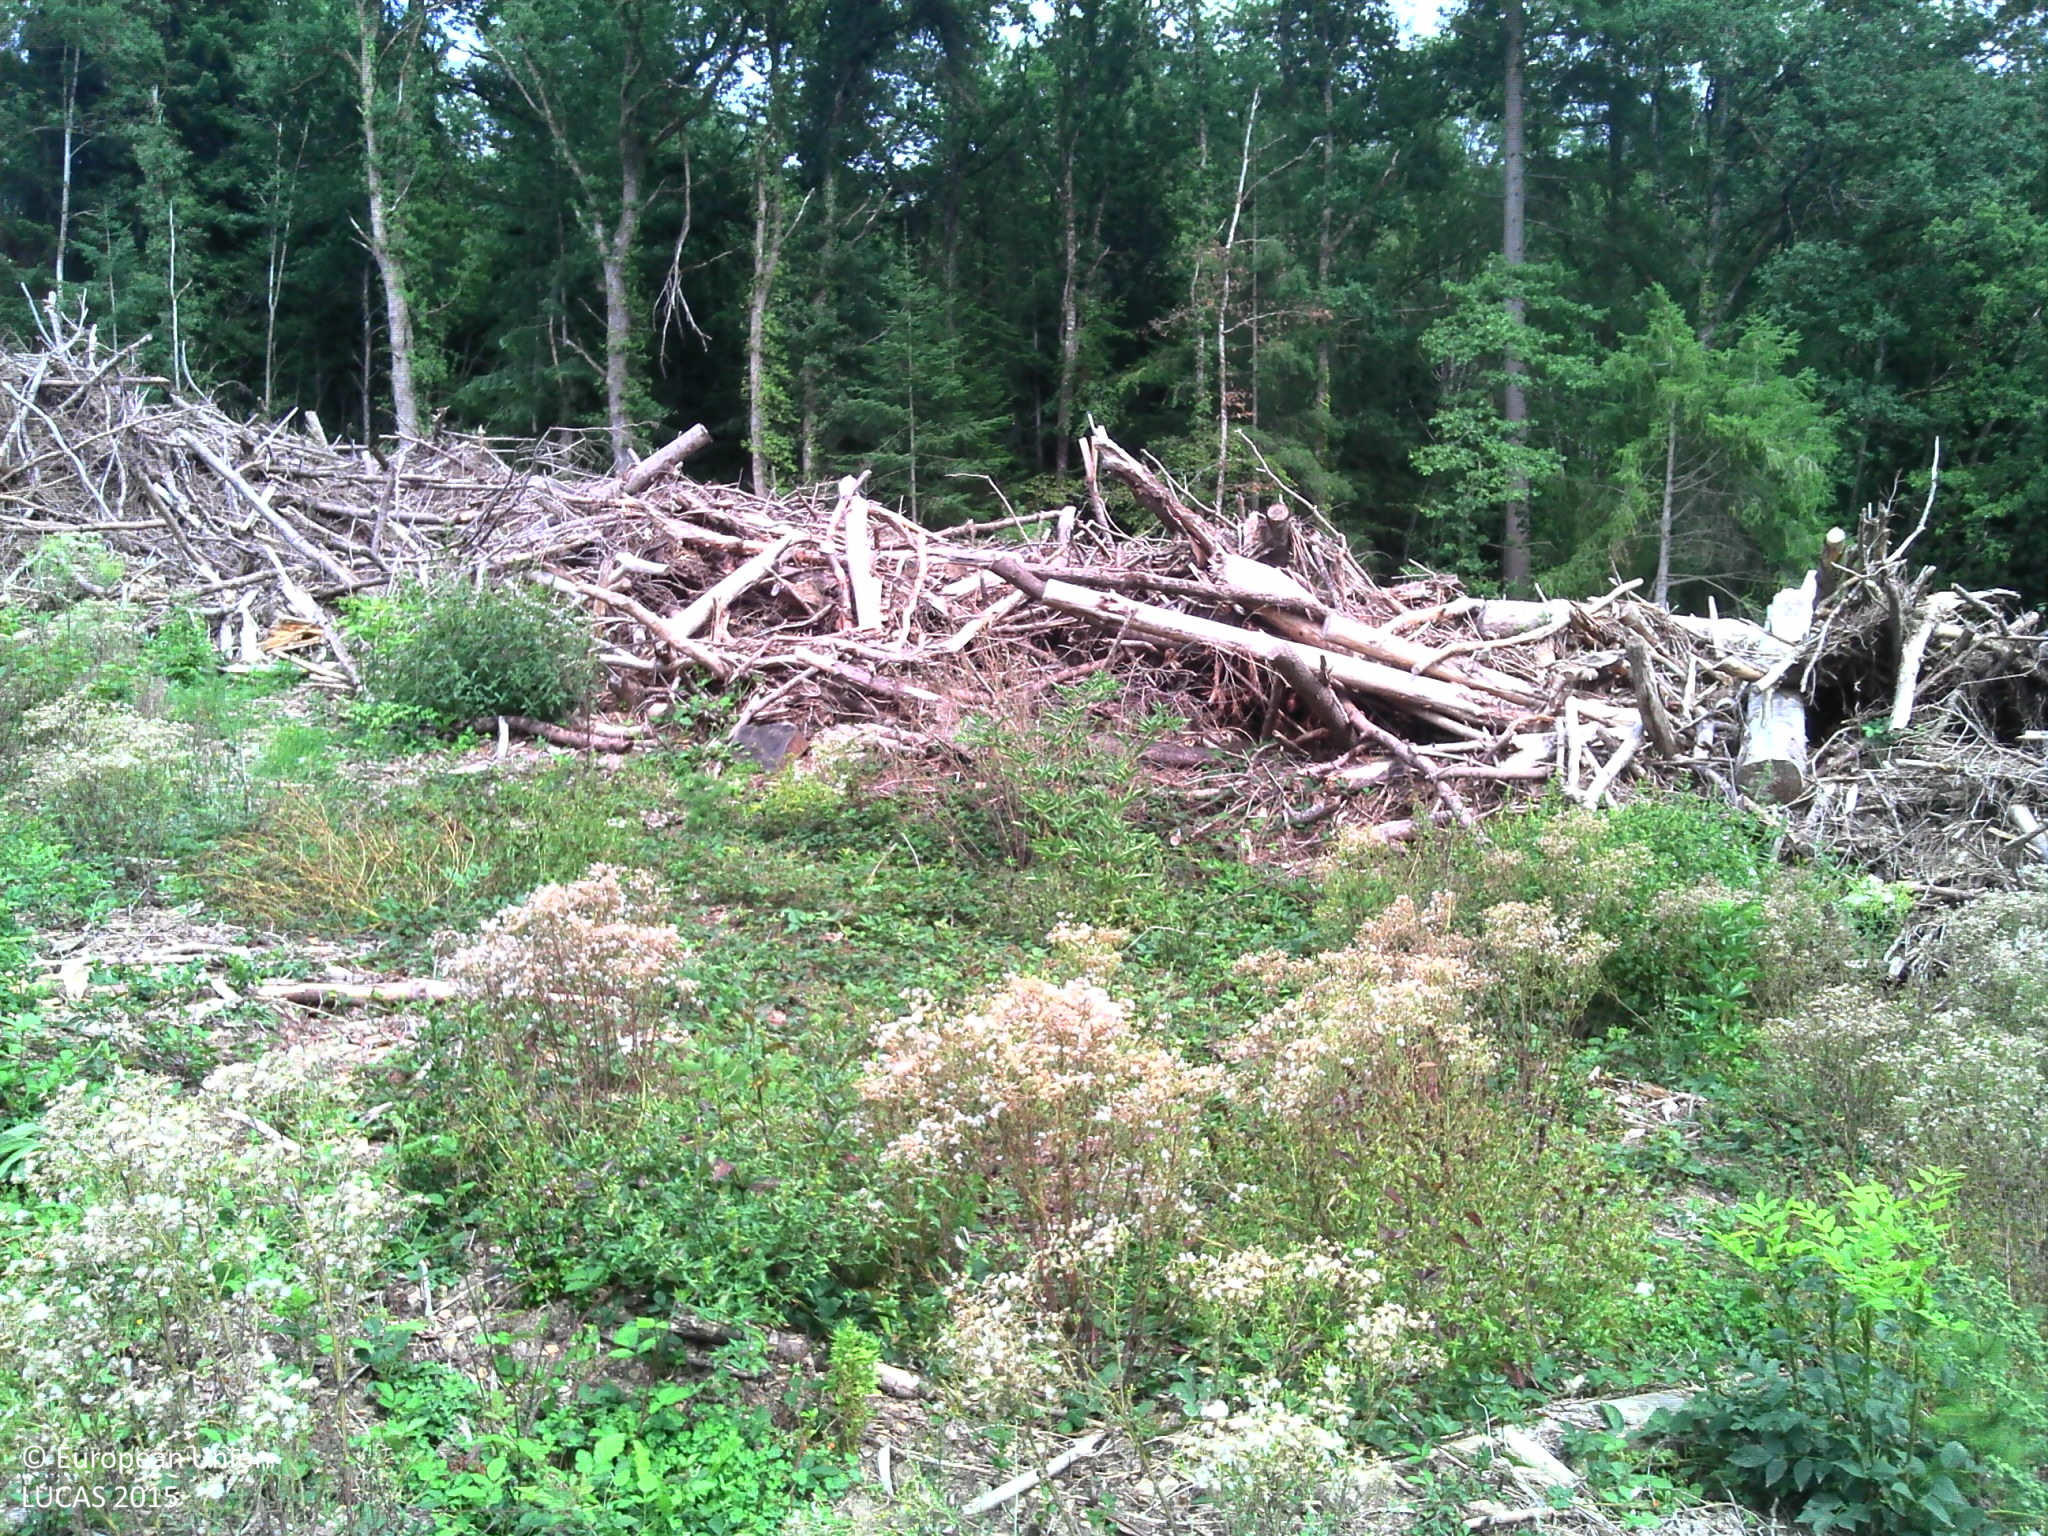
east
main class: Shrubland
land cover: Shrubland without tree cover
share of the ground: > 75 %
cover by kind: shrubs 60 %, herbaceous plants 30 %, consolidated bare surface 10 %
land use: Forestry
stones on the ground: 25 - 50 %
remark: Clear cut
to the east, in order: Shrubland without tree cover; Spruce dominated mixed woodland; Spruce dominated coniferous woodland; Tracks; Spruce dominated coniferous woodland
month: August
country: FR
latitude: 46.2413
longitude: 4.4122
